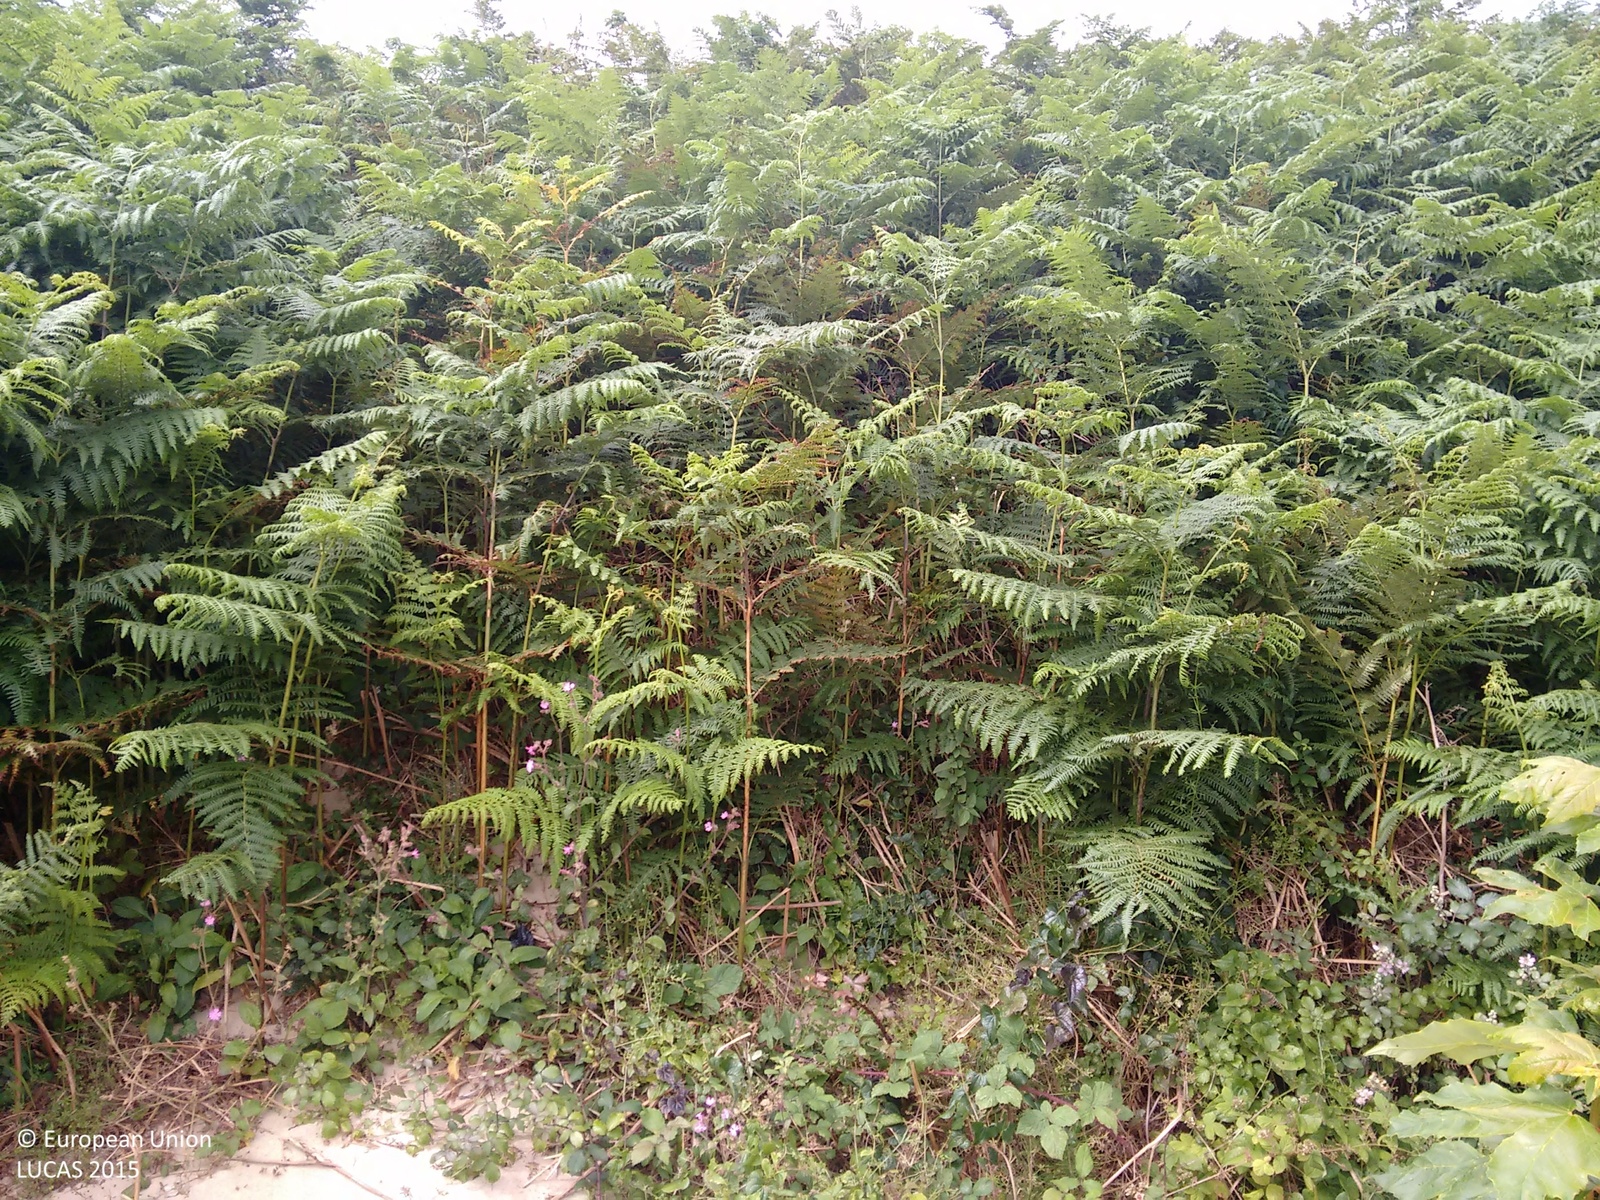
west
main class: Shrubland
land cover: Shrubland without tree cover
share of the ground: > 75 %
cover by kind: shrubs 100 %
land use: Semi-natural and natural areas not in use
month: August
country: GB
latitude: 53.3728
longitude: -4.2735
